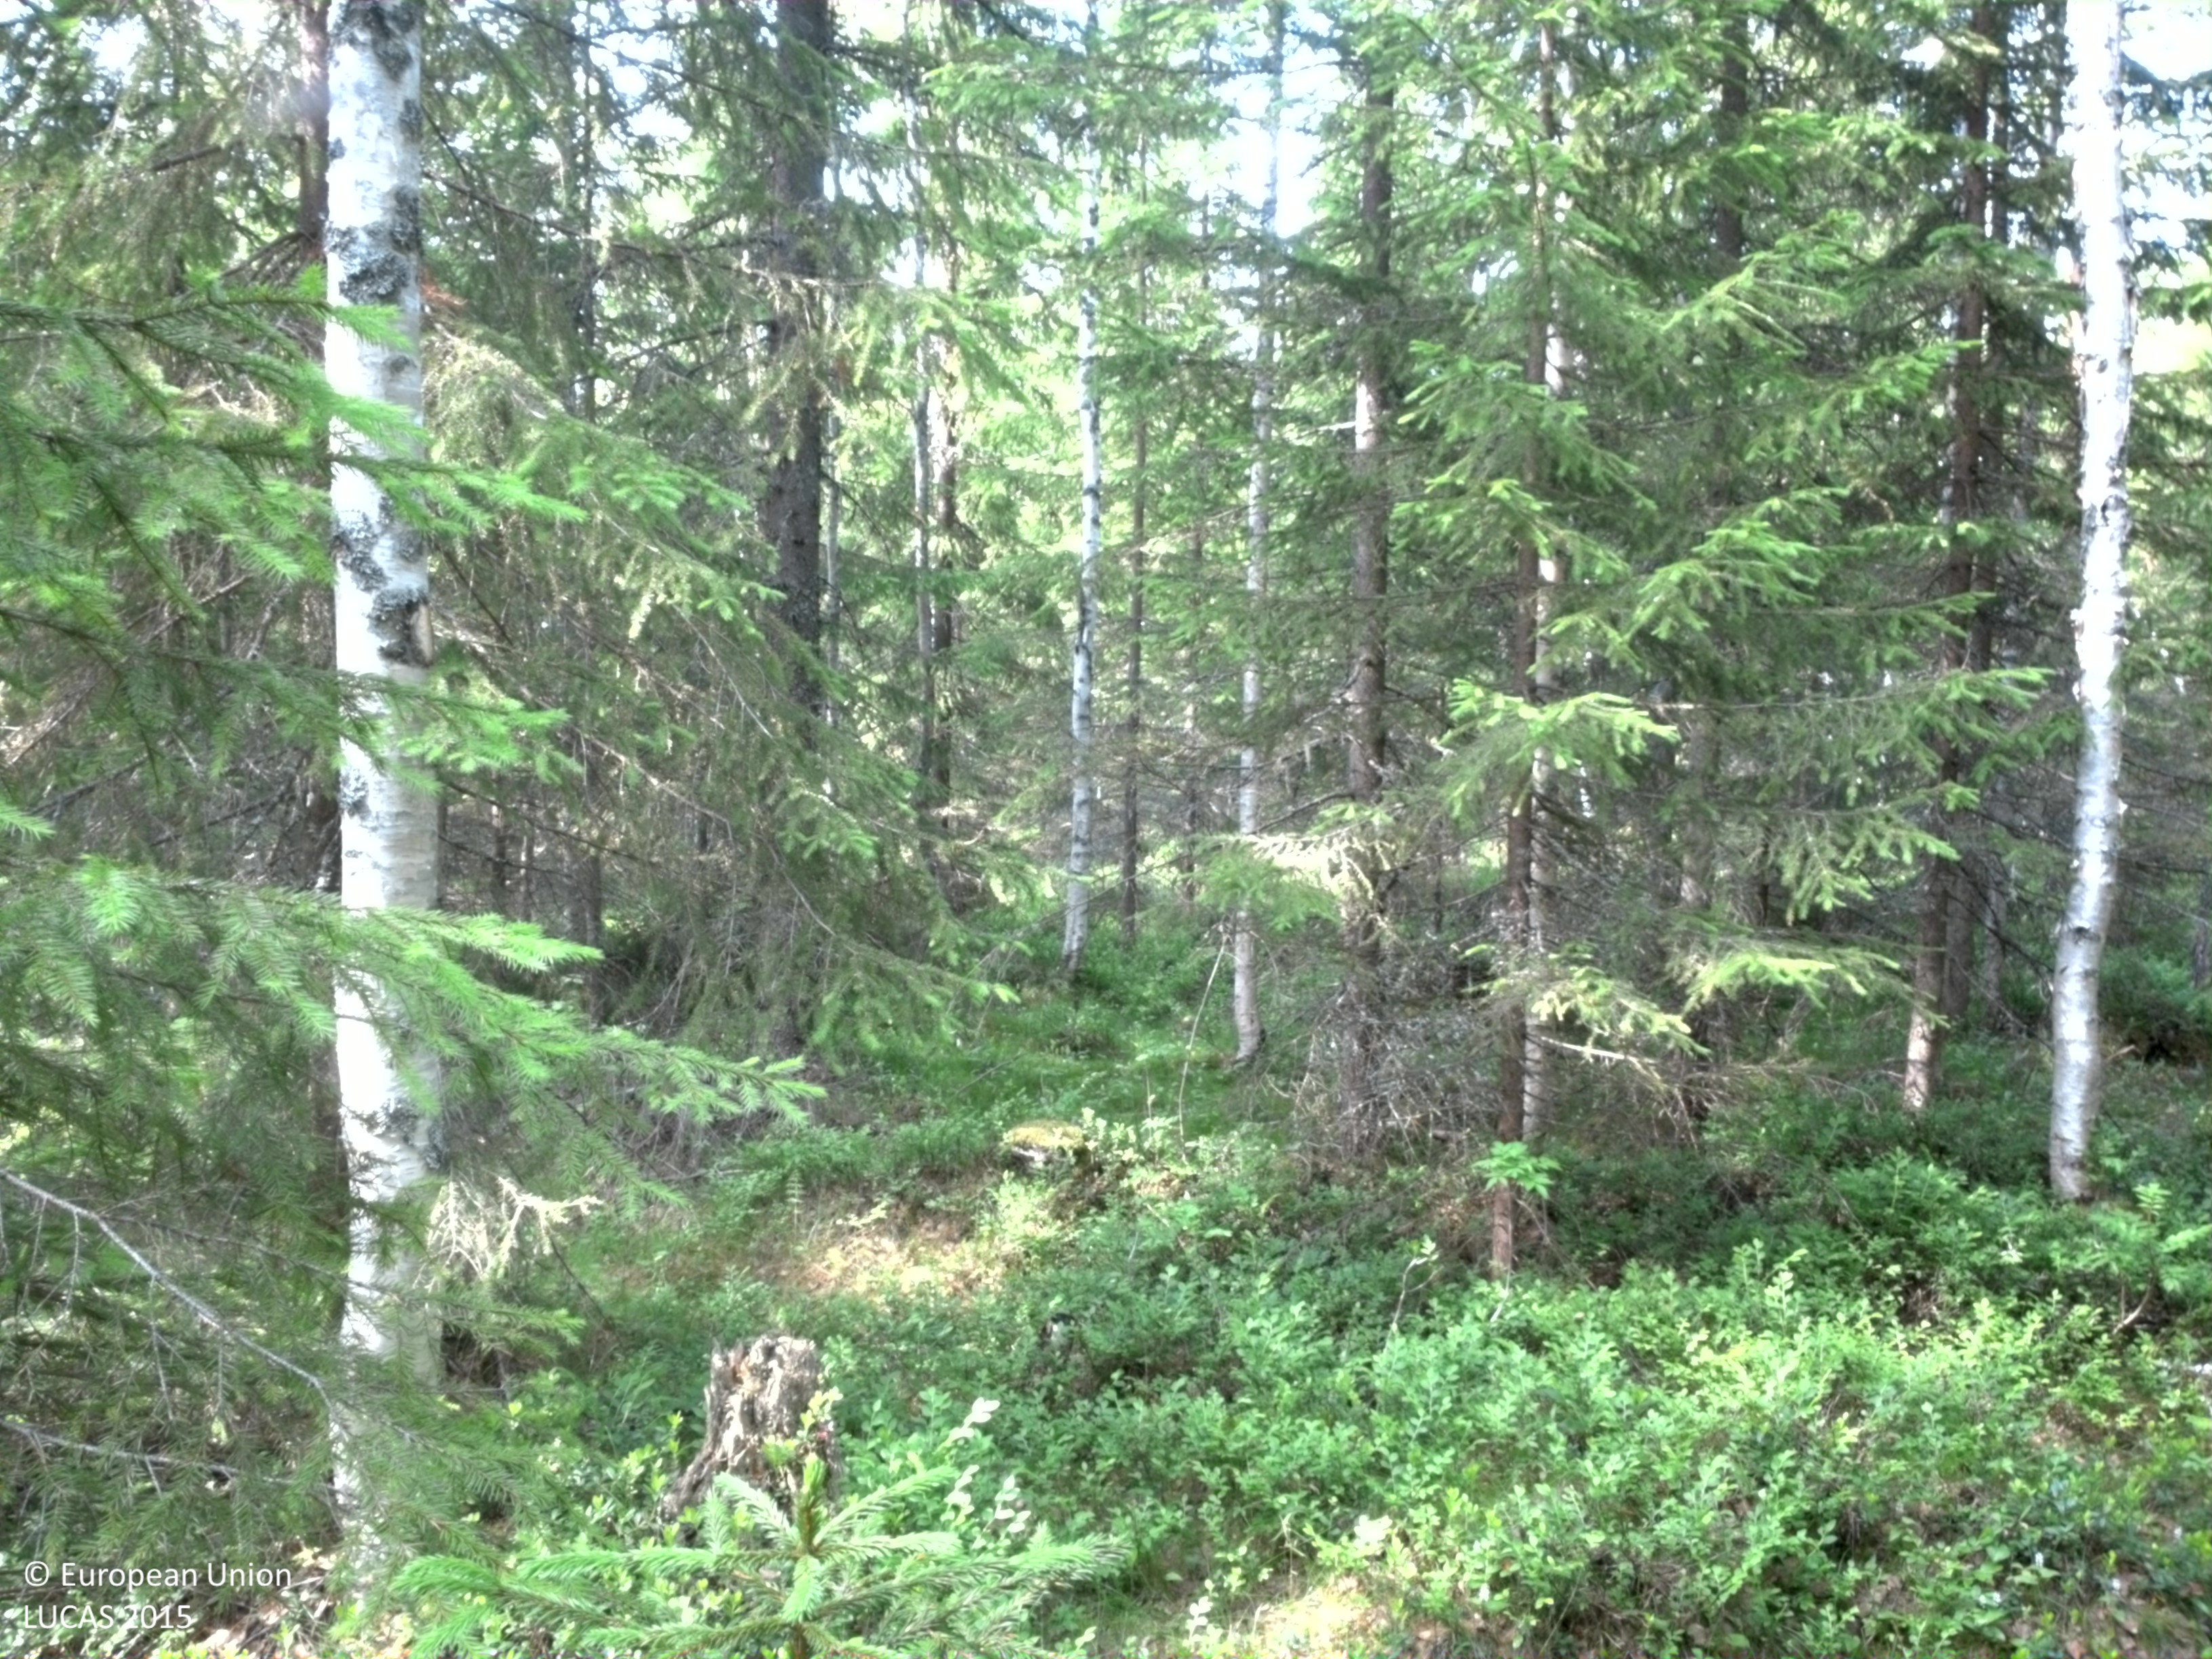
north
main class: Woodland
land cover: Other mixed woodland
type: boreal forest
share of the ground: 50 - 75 %
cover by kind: coniferous forest trees 45 %, shrubs 35 %, broadleaved forest trees 15 %, herbaceous plants 5 %
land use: Forestry
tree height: > 5 m
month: July
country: SE
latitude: 64.4456
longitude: 20.8467
